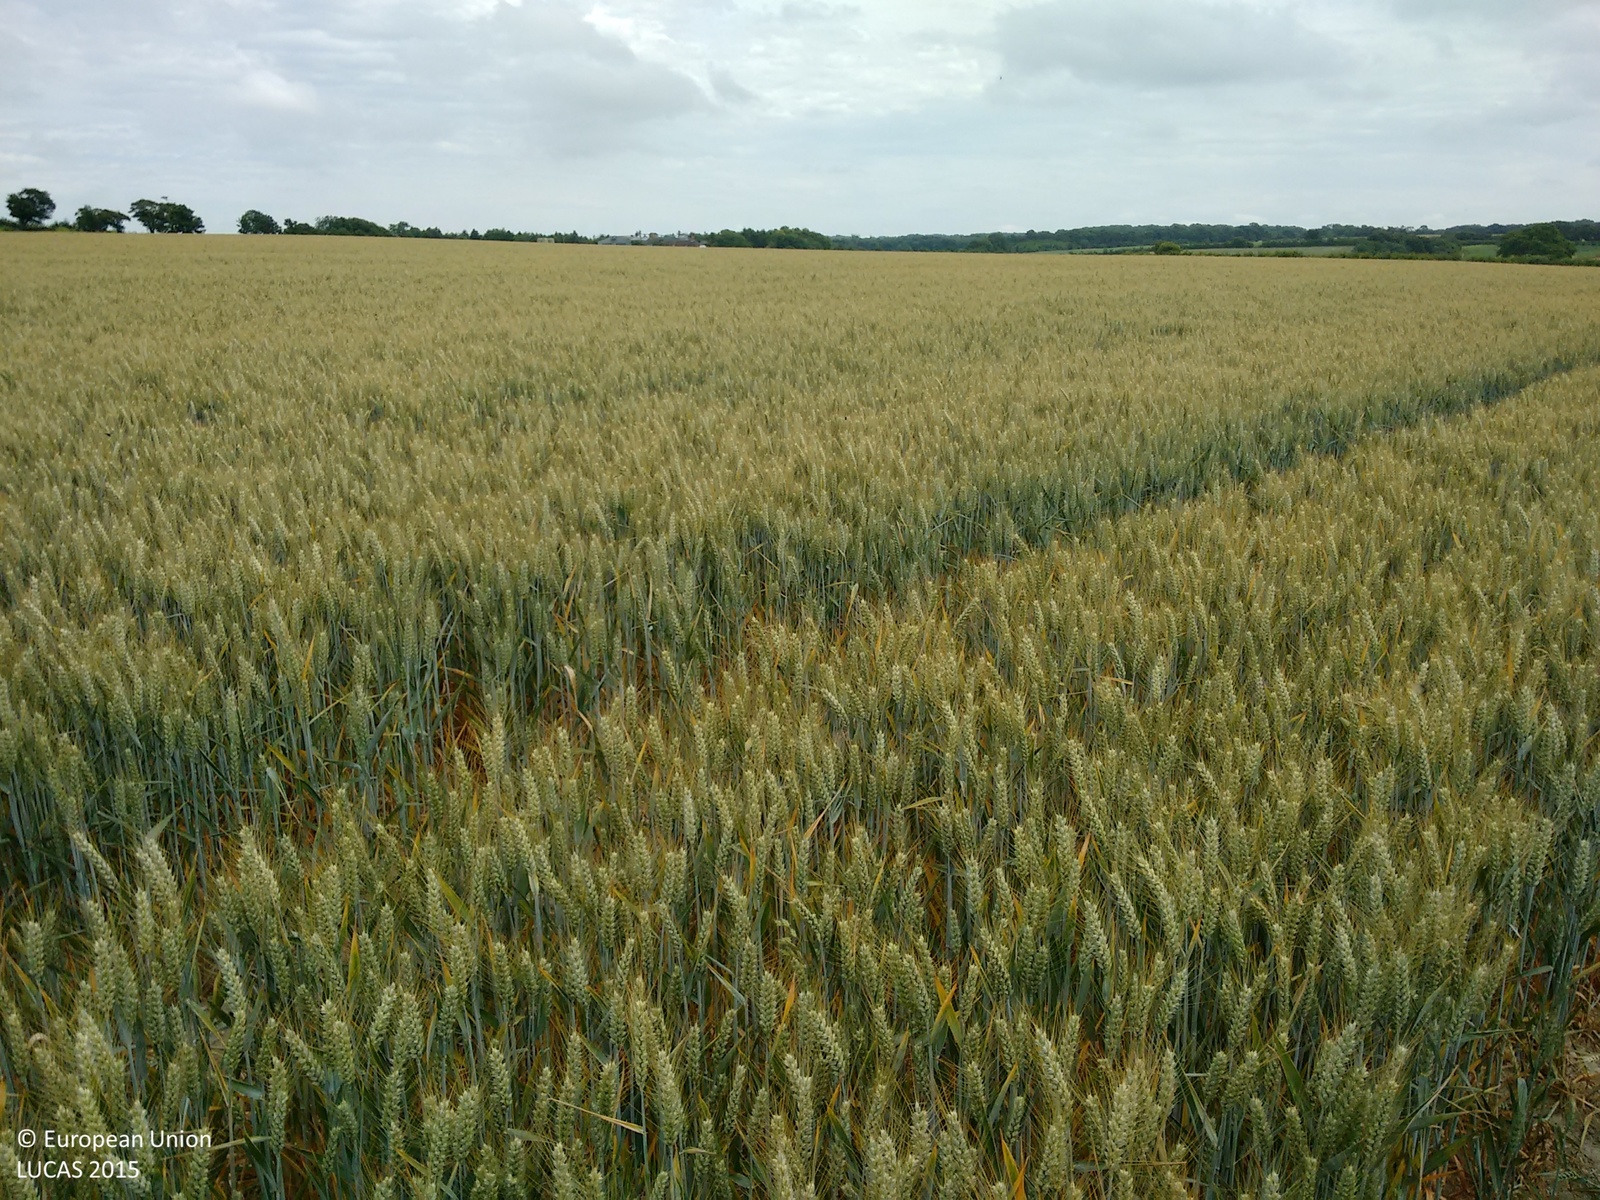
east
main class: Cropland
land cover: Common wheat
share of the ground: > 75 %
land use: Agriculture (excluding fallow land and kitchen gardens)
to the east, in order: Common wheat
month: July
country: GB
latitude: 51.6019
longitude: -1.0906
